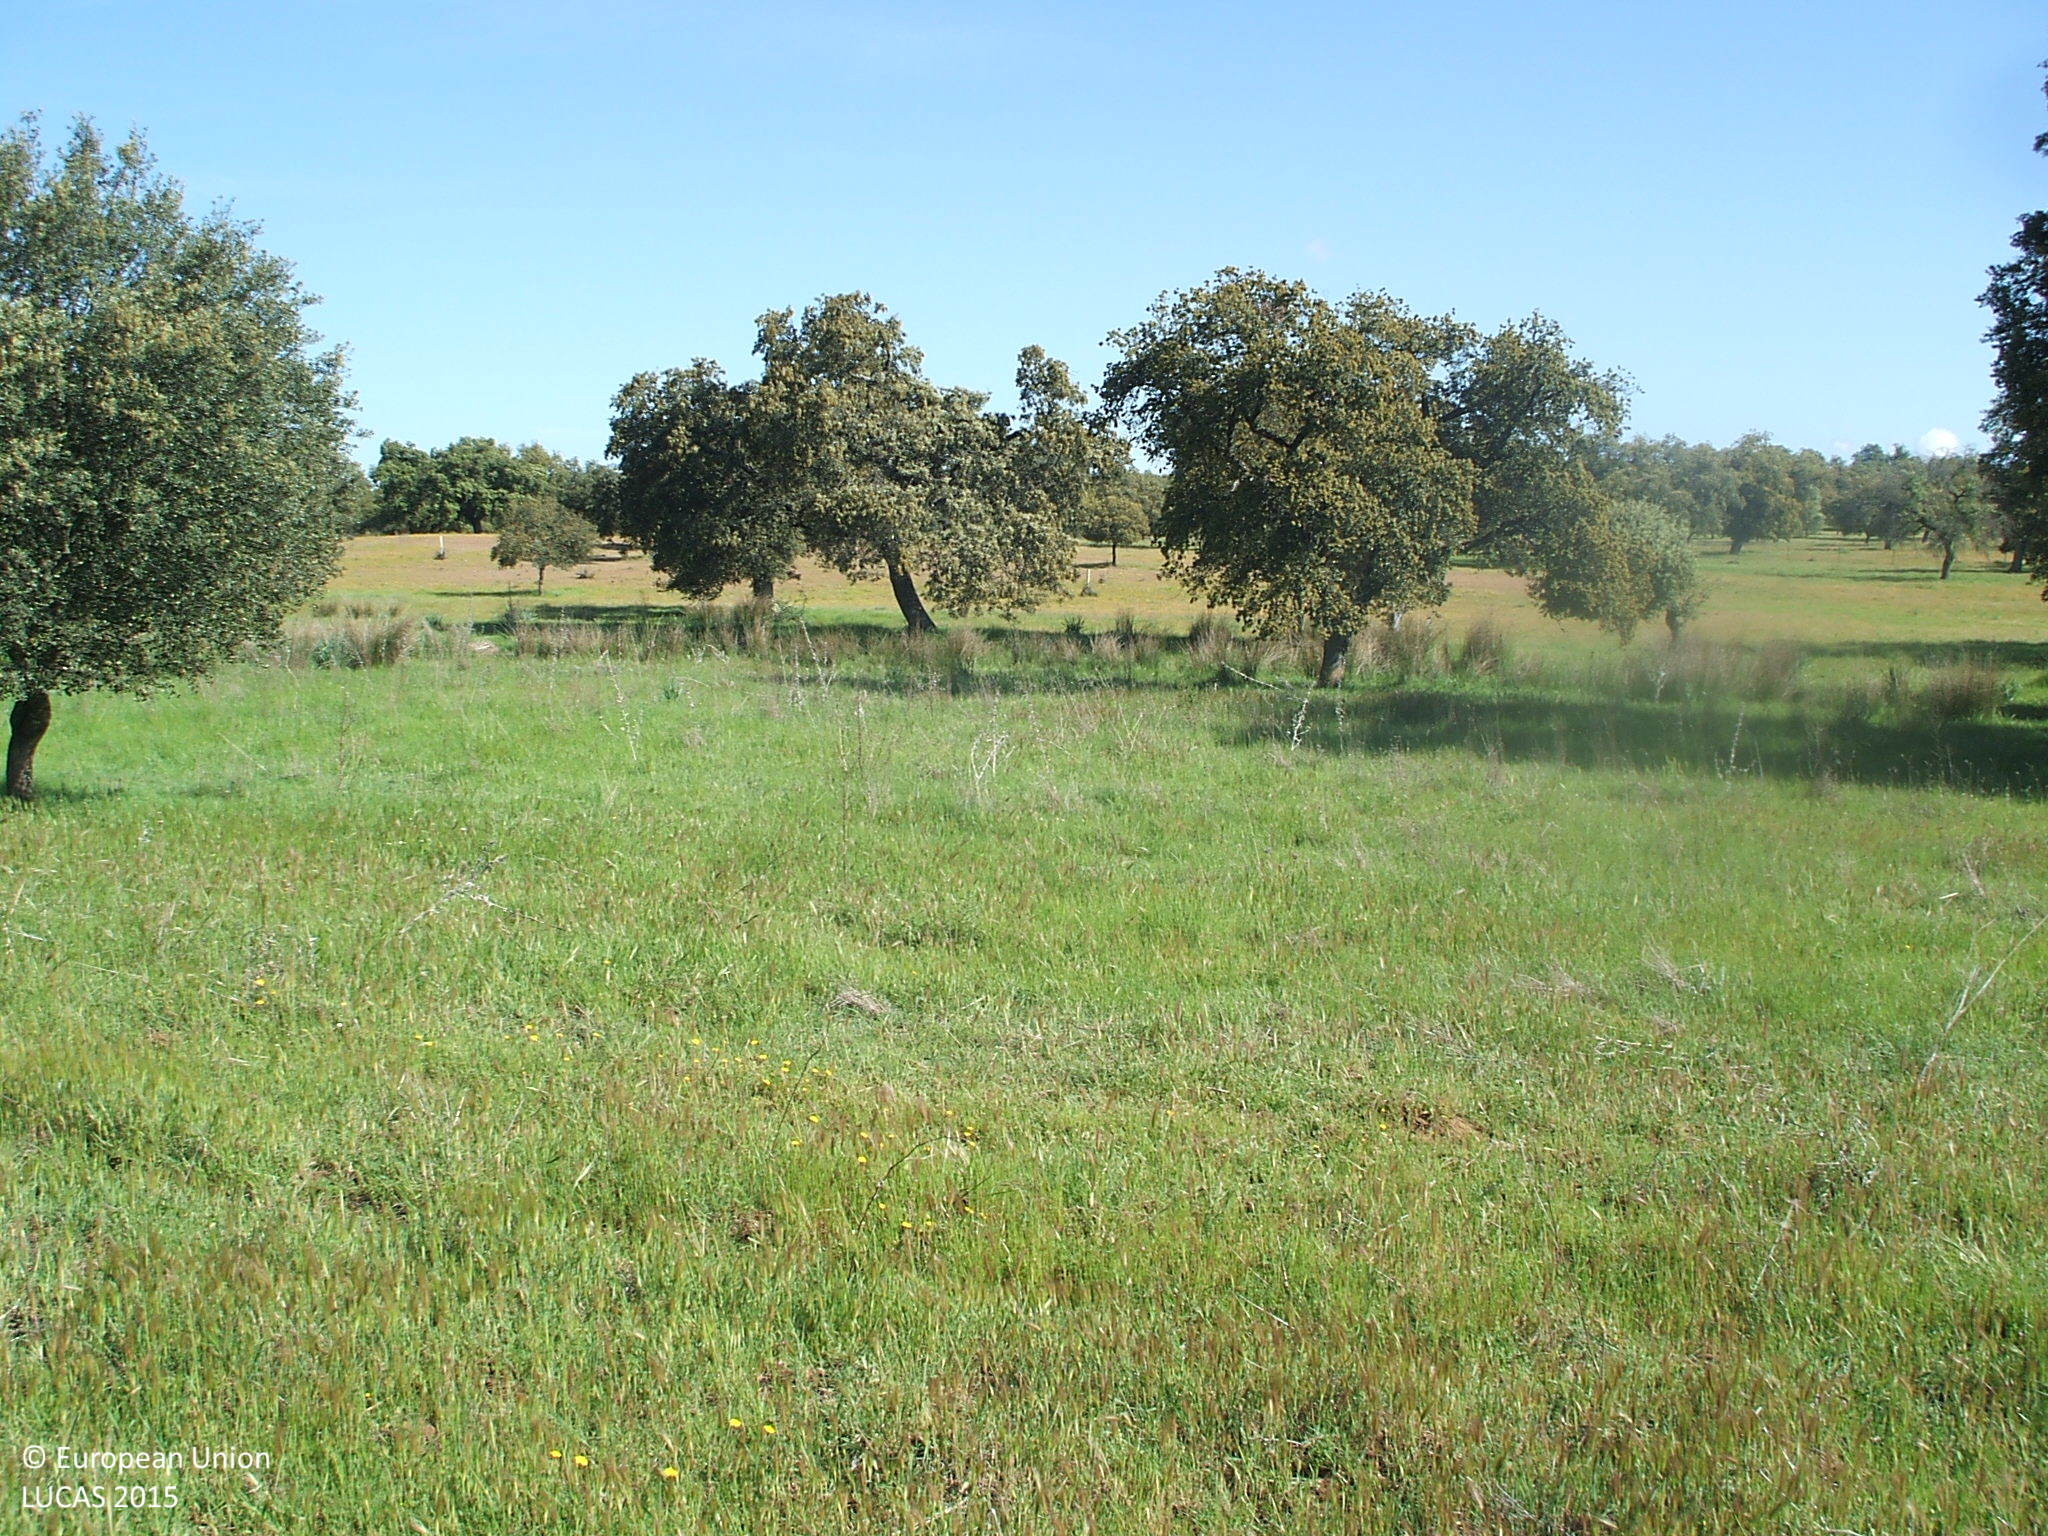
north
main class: Woodland
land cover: Broadleaved woodland
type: broadleaved evergreen forest
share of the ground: 25 - 50 %
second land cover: Grassland without tree/shrub cover
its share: > 75 %
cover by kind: herbaceous plants 75 %, broadleaved forest trees 25 %
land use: Forestry
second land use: Agriculture (excluding fallow land and kitchen gardens)
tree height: > 5 m
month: April
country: ES
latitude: 38.0136
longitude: -5.6221
